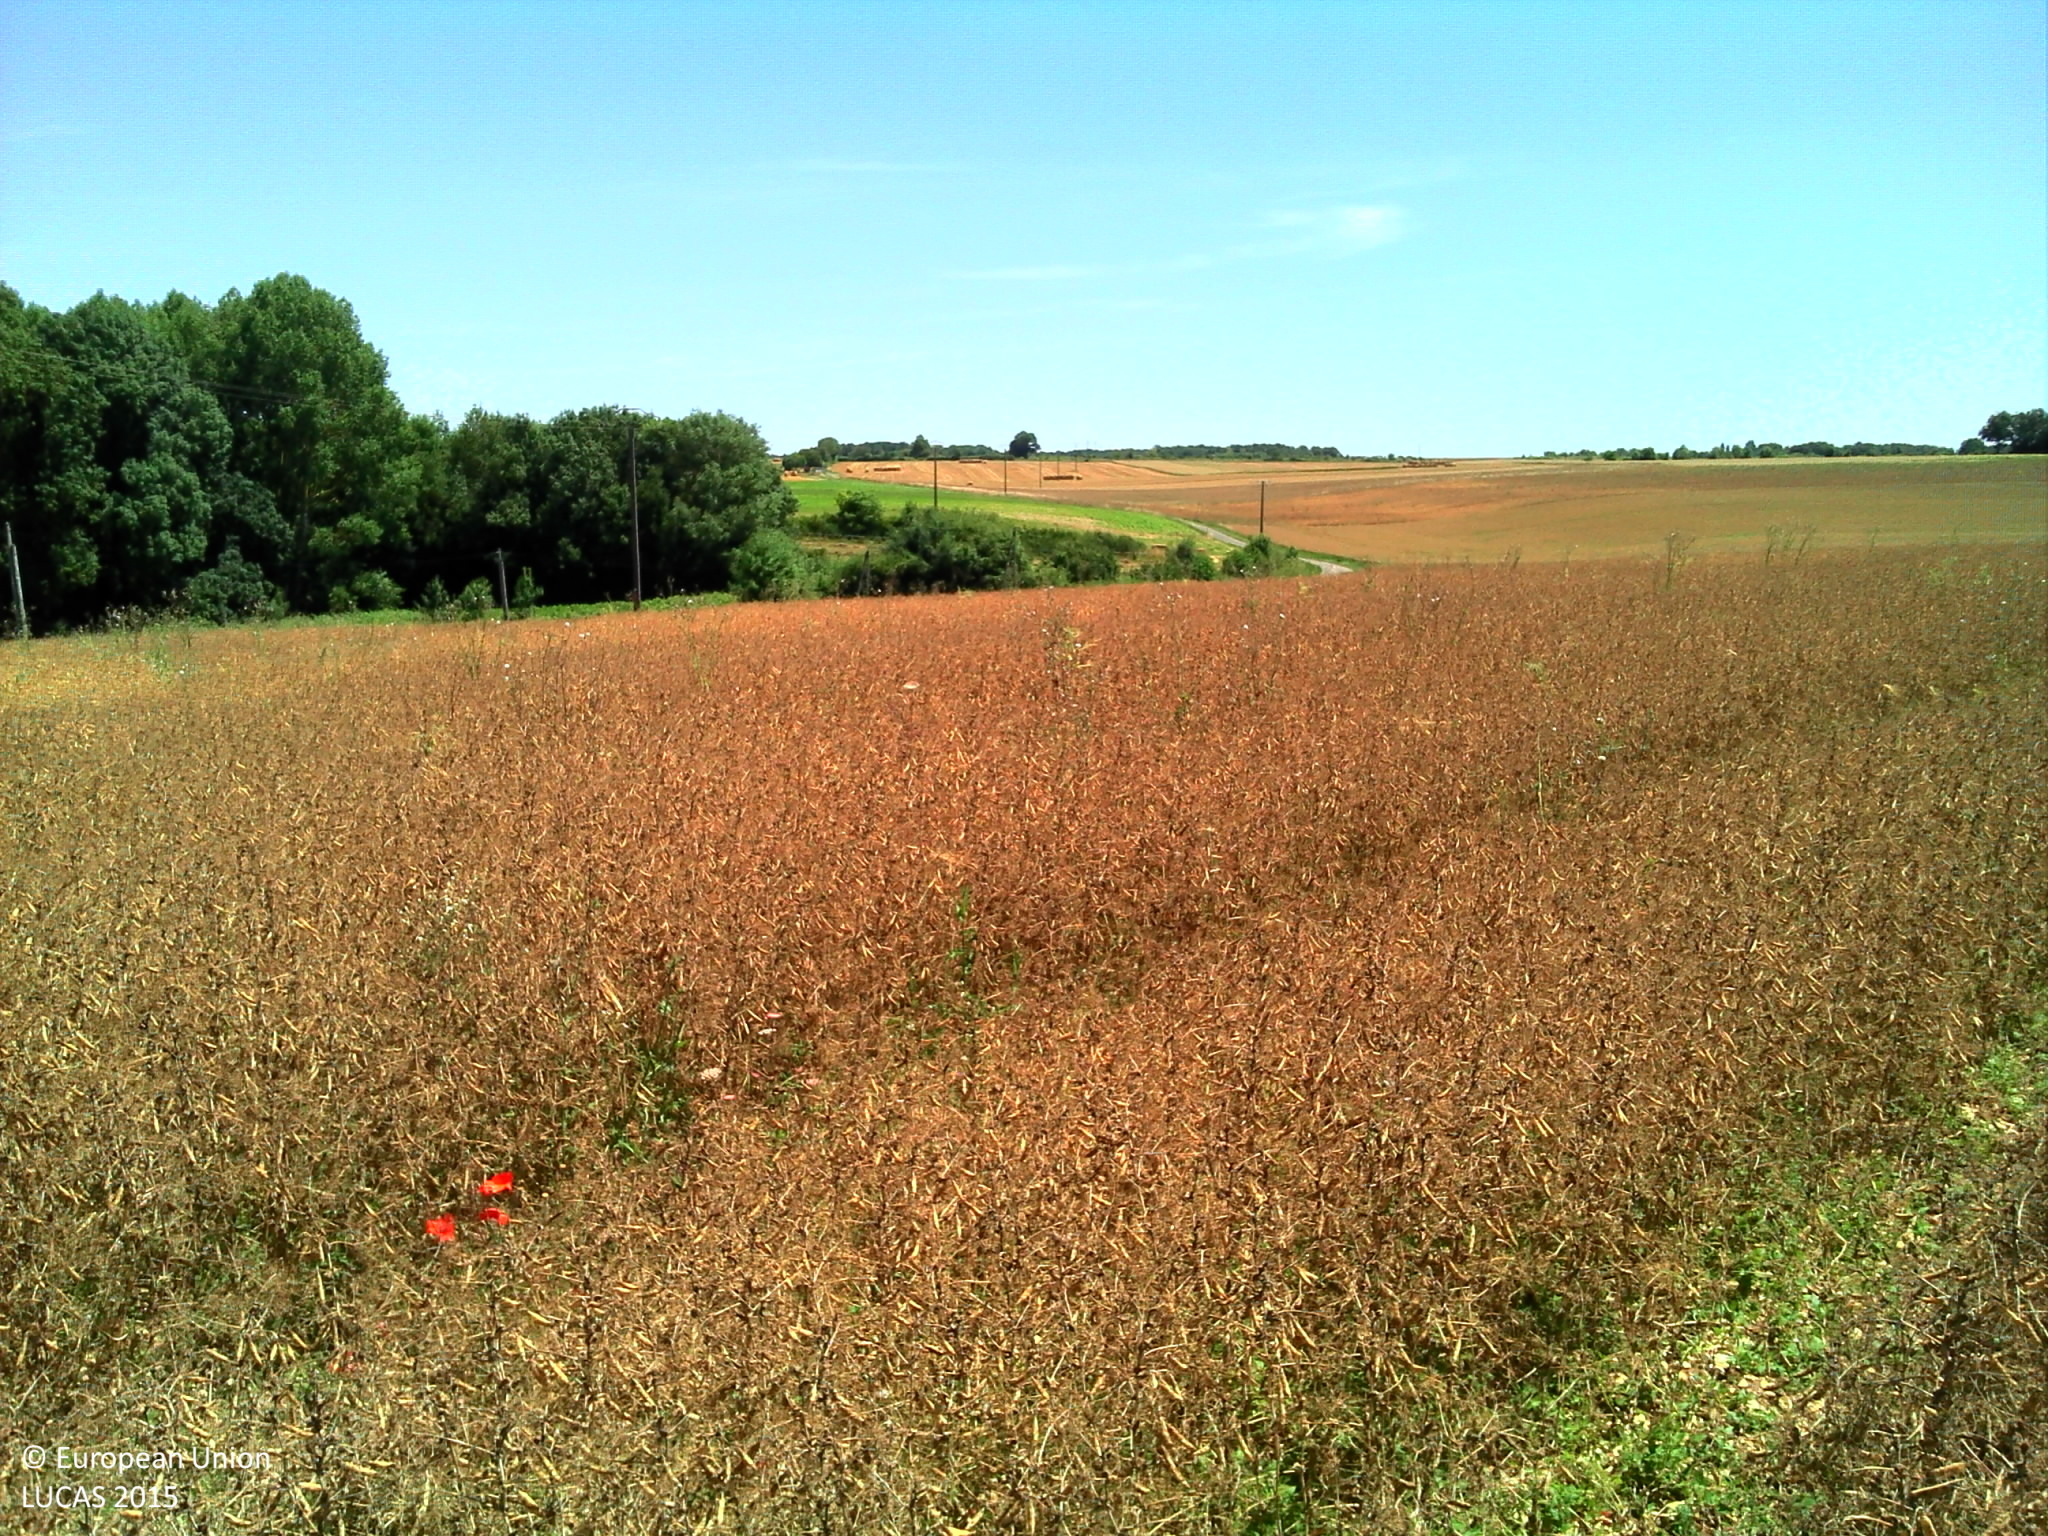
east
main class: Cropland
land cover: Dry pulses
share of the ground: > 75 %
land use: Agriculture (excluding fallow land and kitchen gardens)
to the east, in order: Dry pulses; Grass margins; Paved roads, cycling and walking lanes; Grass margins; Ditches and canals; Fences; Managed hedges; Grassland without tree/shrub cover
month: June
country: FR
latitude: 45.8517
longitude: -0.6753
